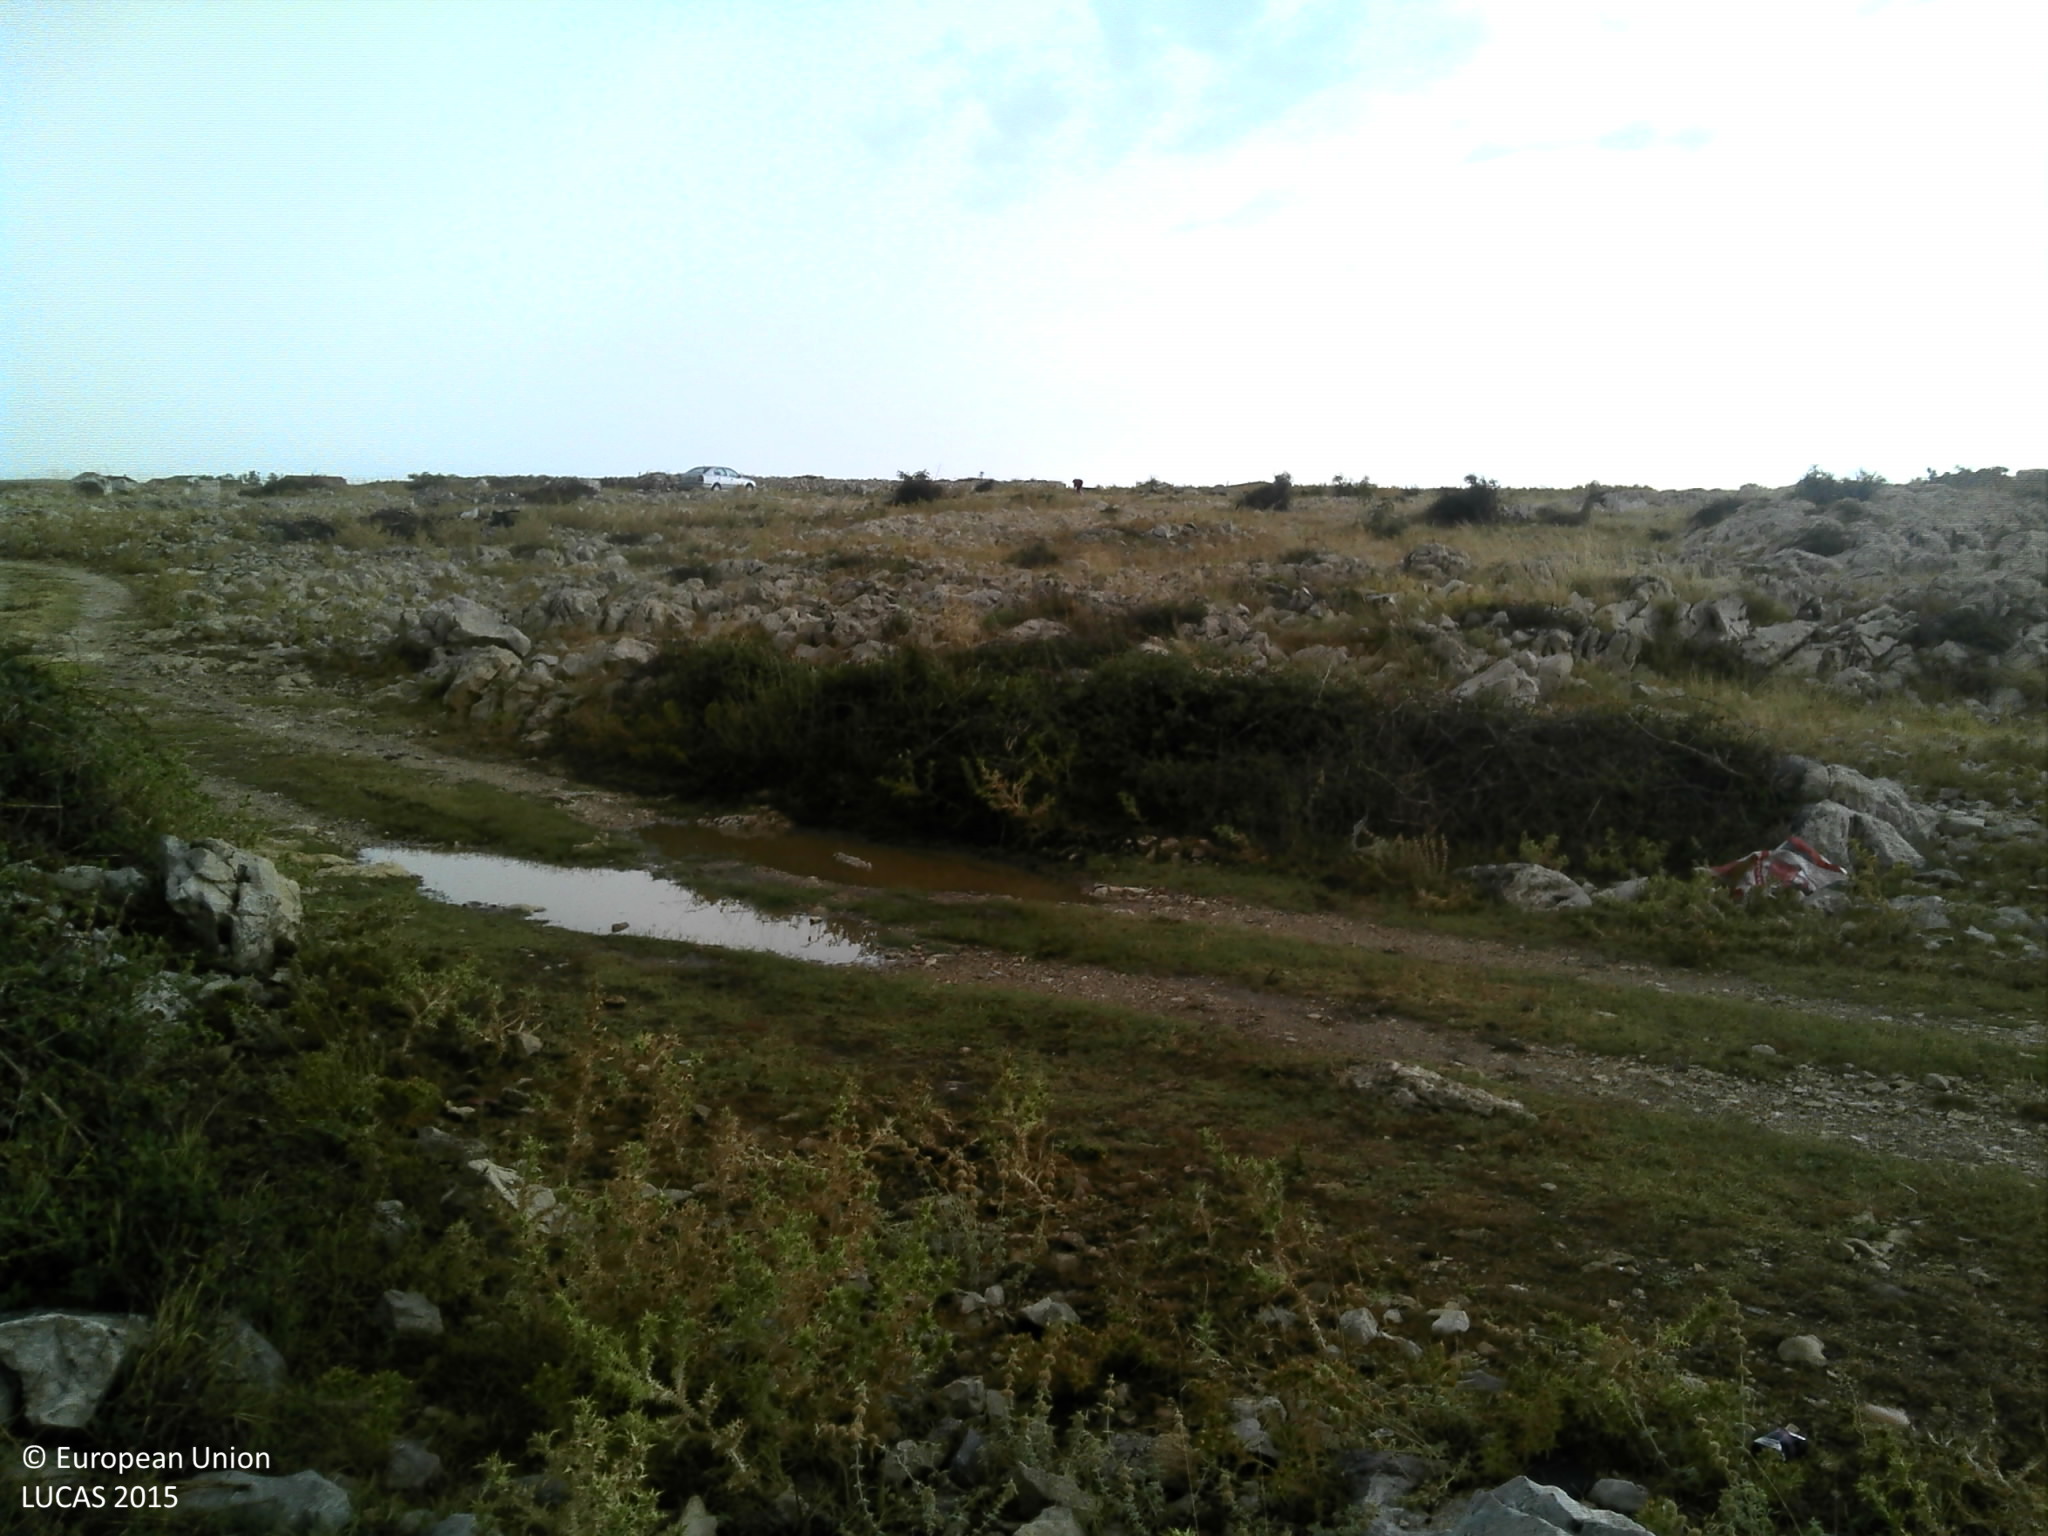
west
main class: Grassland
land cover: Grassland without tree/shrub cover
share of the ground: 50 - 75 %
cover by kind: herbaceous plants 50 %, unconsolidated bare surface 45 %, shrubs 5 %
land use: Agriculture (excluding fallow land and kitchen gardens)
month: July
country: HR
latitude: 44.3505
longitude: 15.1235
